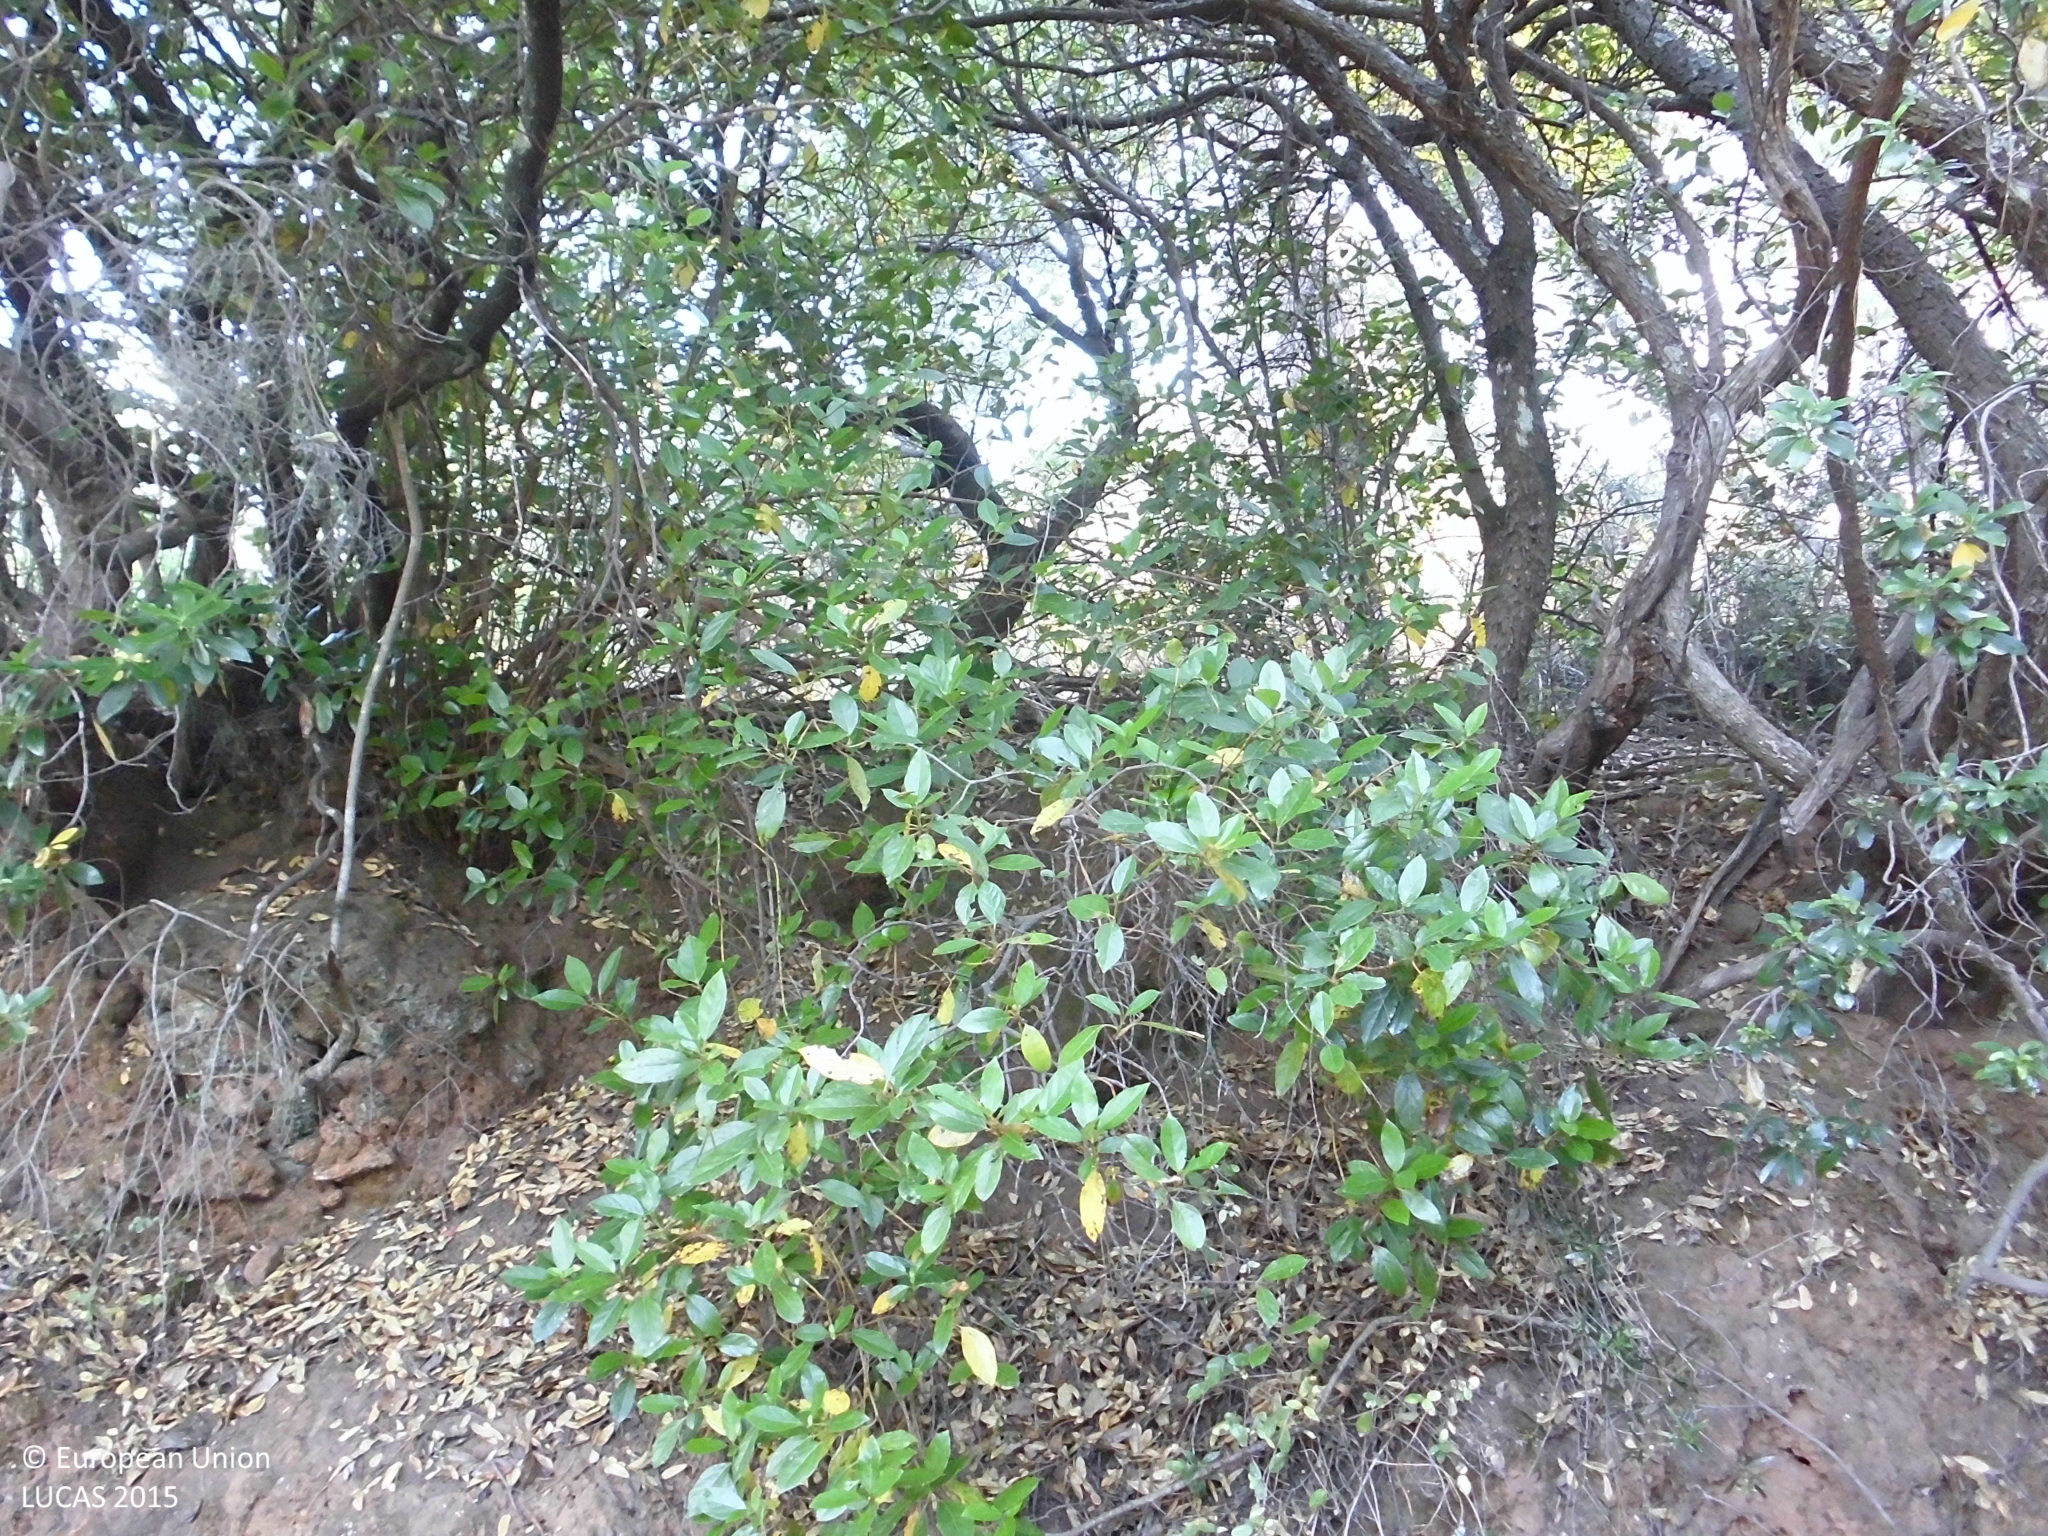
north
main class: Woodland
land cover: Pine dominated mixed woodland
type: thermophilous deciduous forest
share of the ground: > 75 %
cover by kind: coniferous forest trees 50 %, broadleaved forest trees 25 %, shrubs 20 %, herbaceous plants 5 %
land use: Forestry
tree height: > 5 m
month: June
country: ES
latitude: 40.1169
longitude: -5.4668
